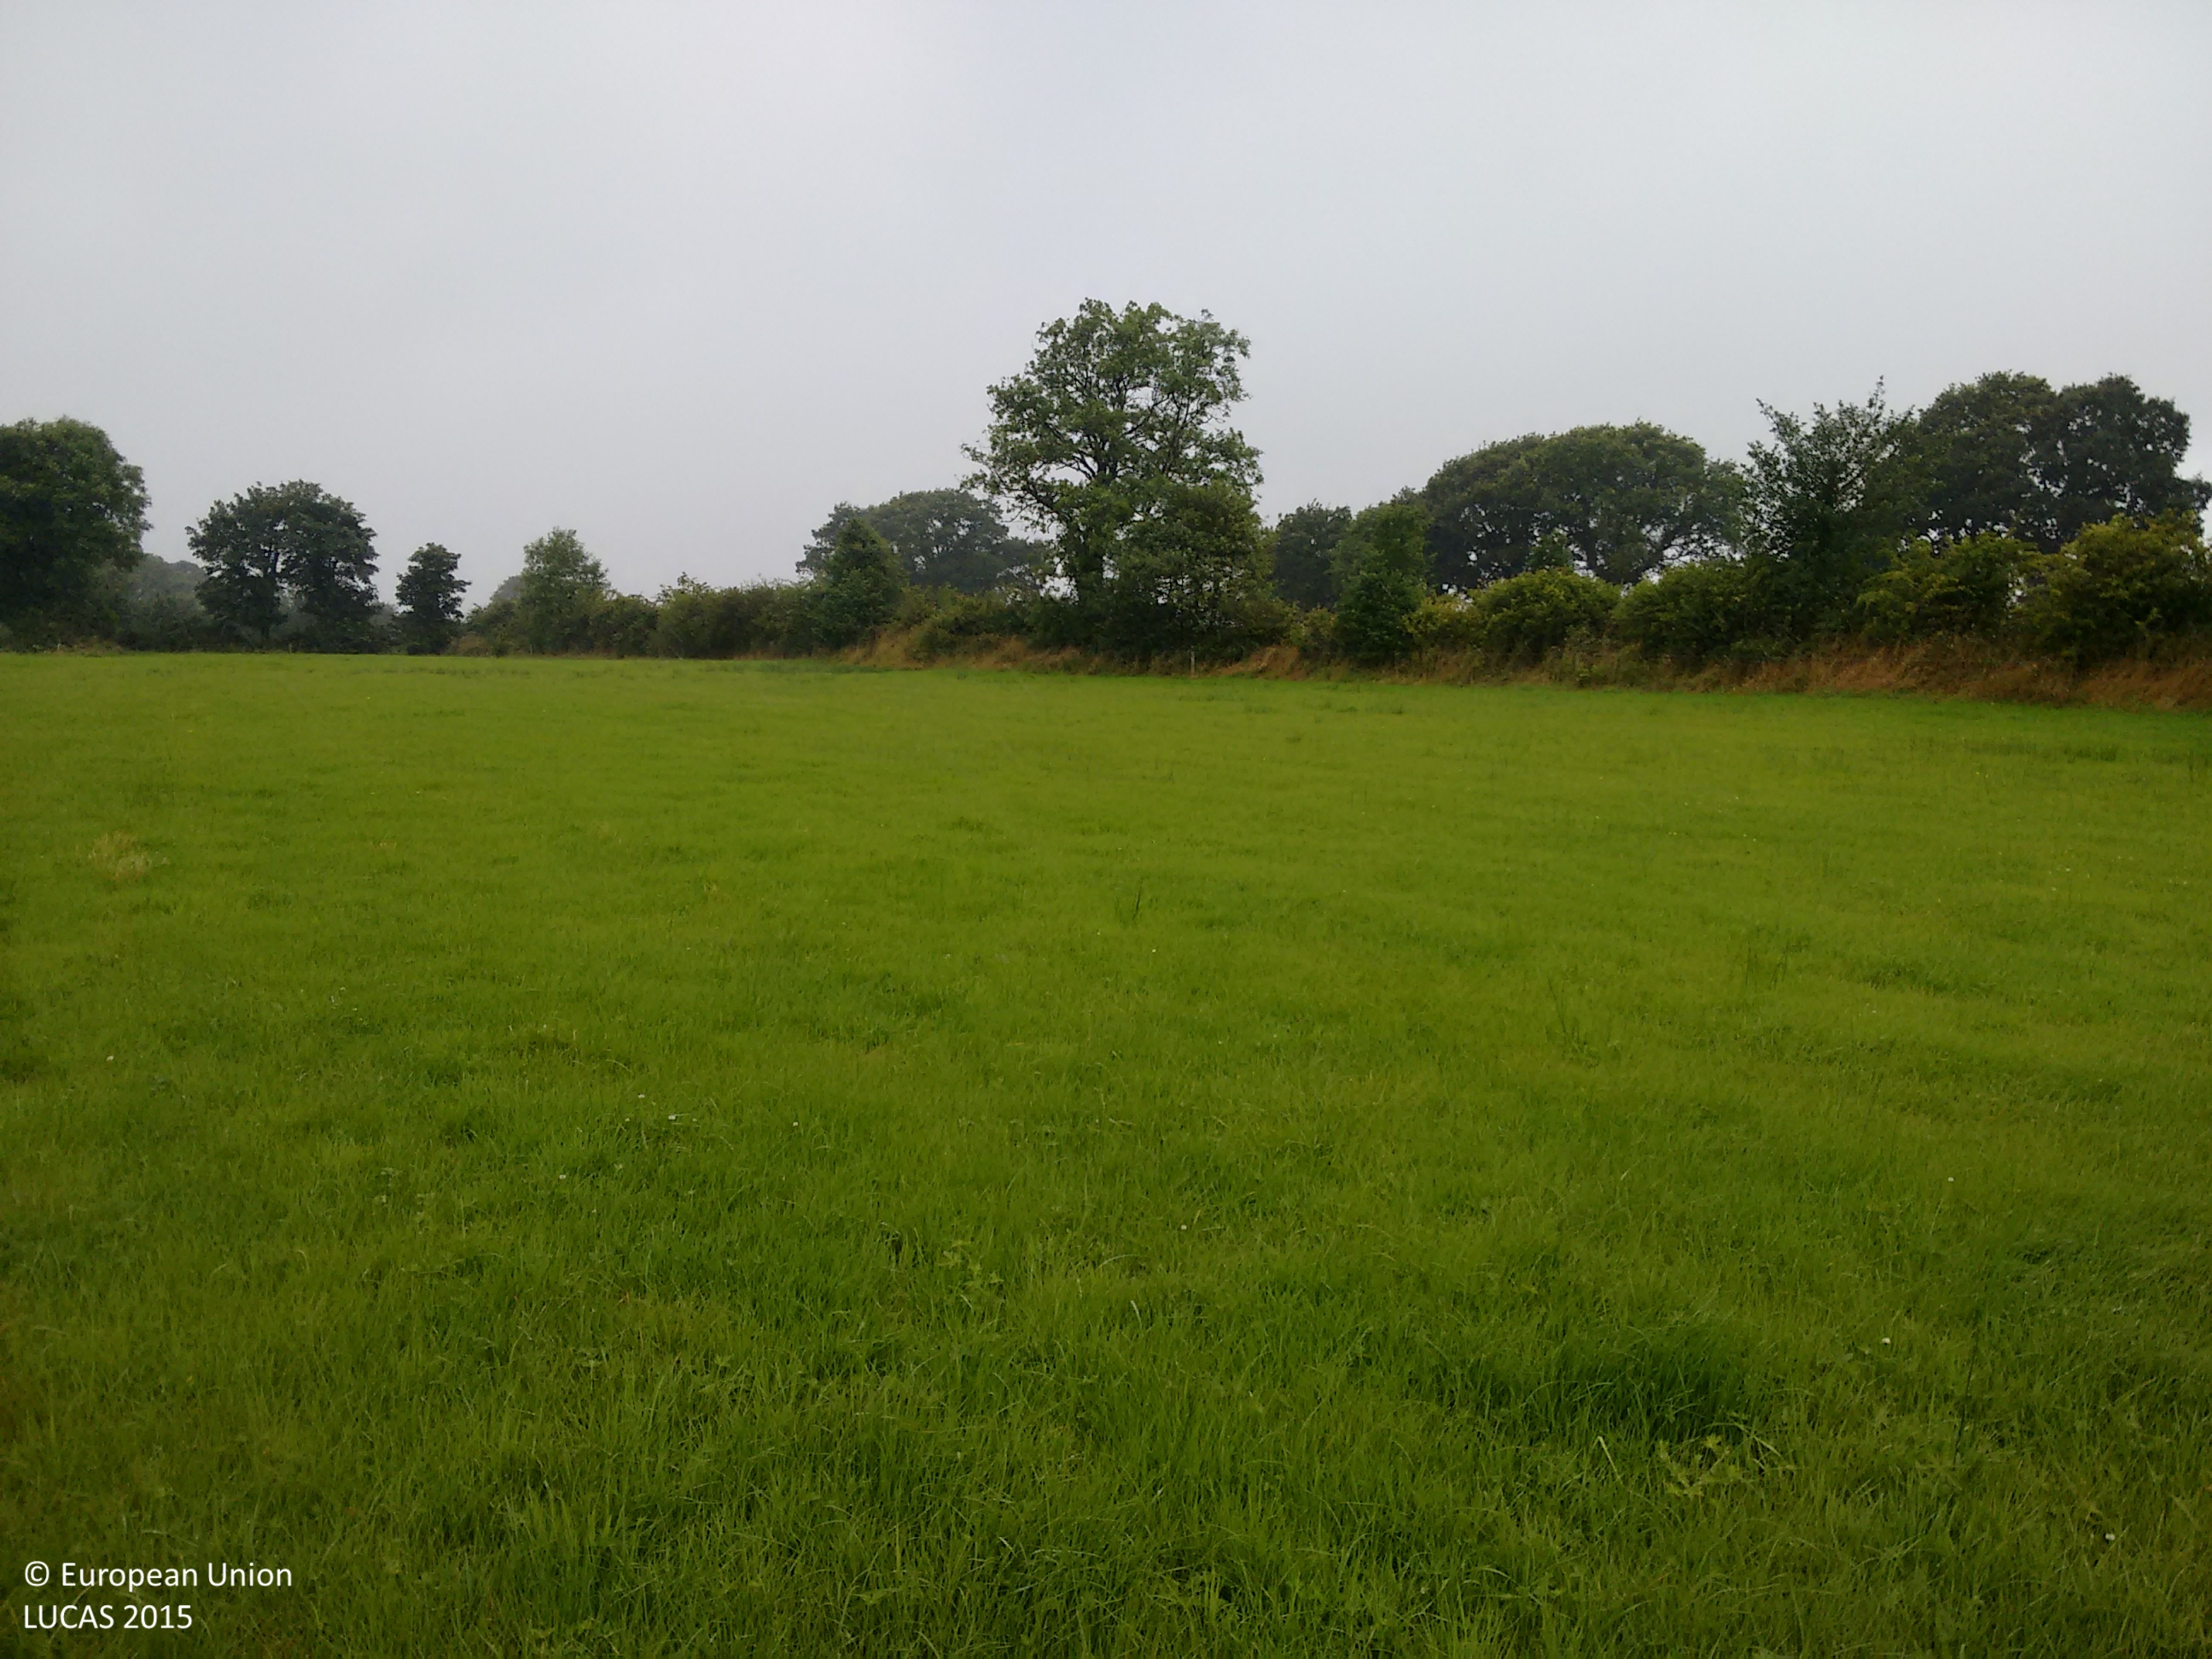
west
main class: Grassland
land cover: Grassland without tree/shrub cover
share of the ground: > 75 %
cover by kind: herbaceous plants 100 %
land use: Agriculture (excluding fallow land and kitchen gardens)
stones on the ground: < 10 %
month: July
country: IE
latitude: 53.7801
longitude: -7.8176
